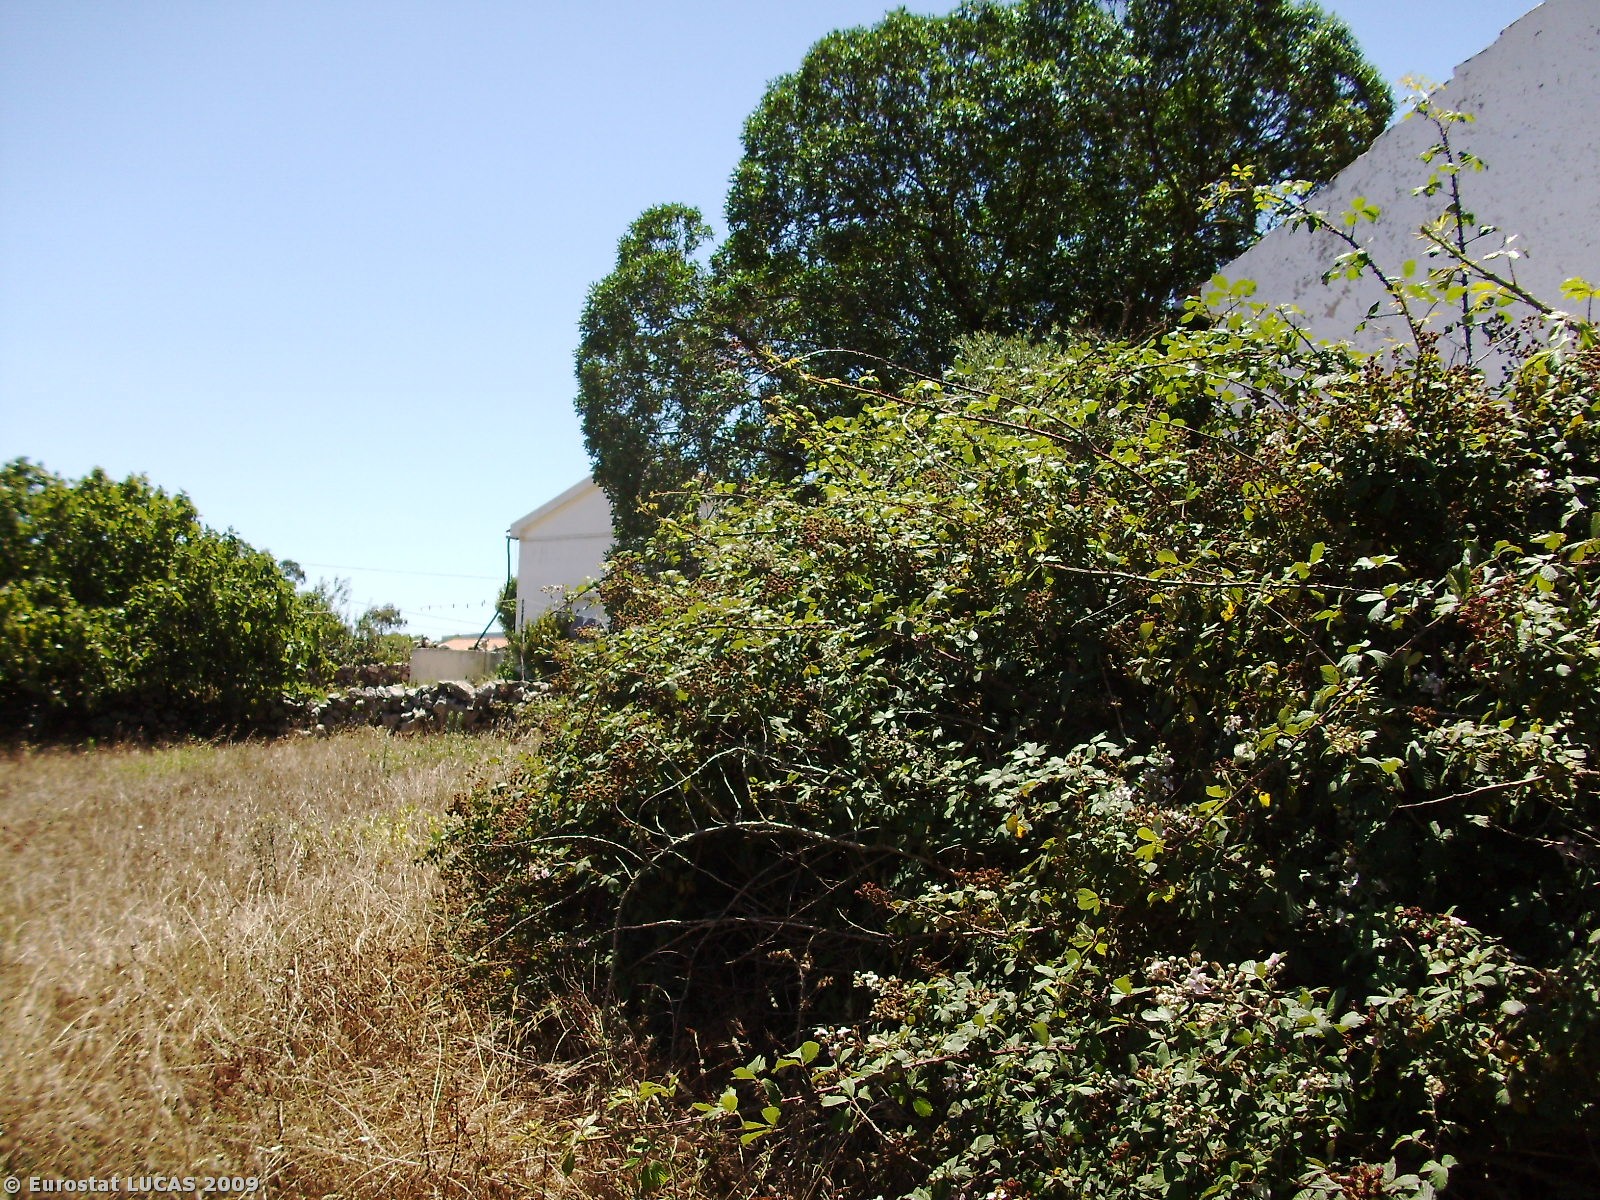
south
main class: Grassland
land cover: Spontaneously vegetated surfaces
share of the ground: > 75 %
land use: Fallow land
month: July
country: PT
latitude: 39.4492
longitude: -8.8963
